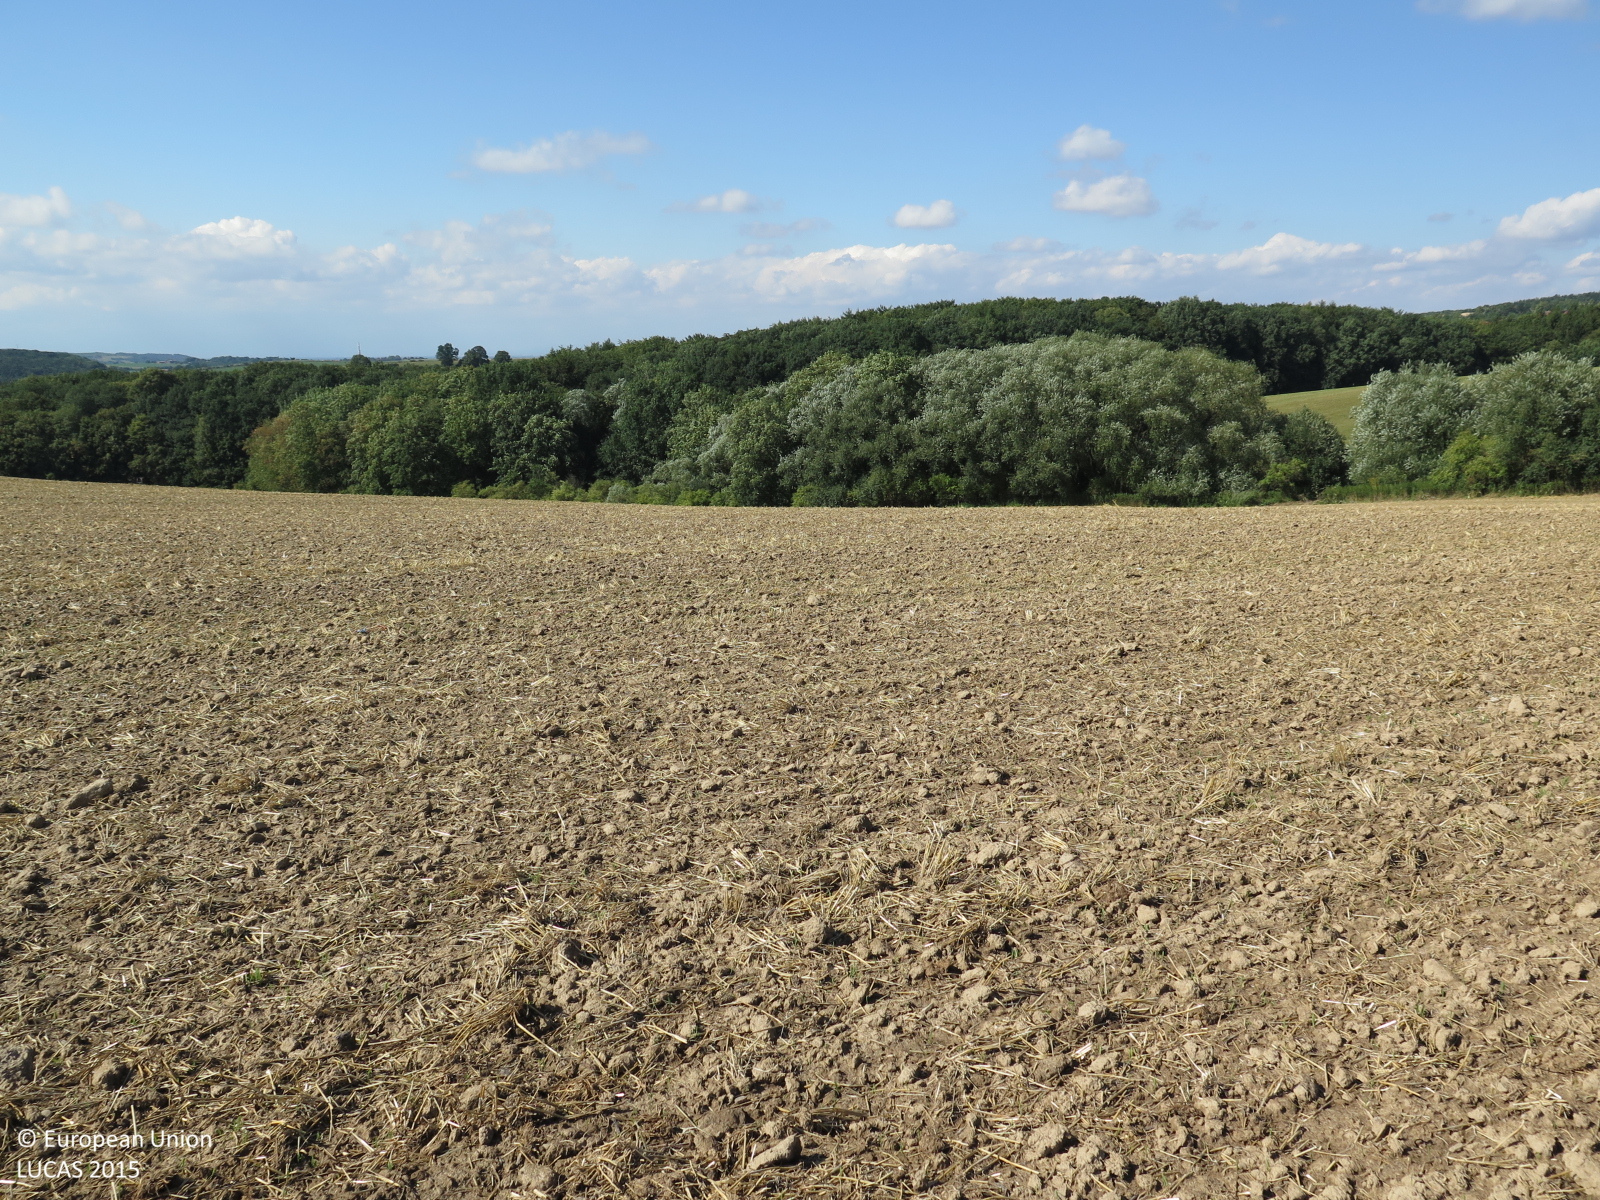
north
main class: Cropland
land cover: Common wheat
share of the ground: < 10 %
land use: Agriculture (excluding fallow land and kitchen gardens)
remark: Harvested field
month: July
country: CZ
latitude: 49.1379
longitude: 17.5645
